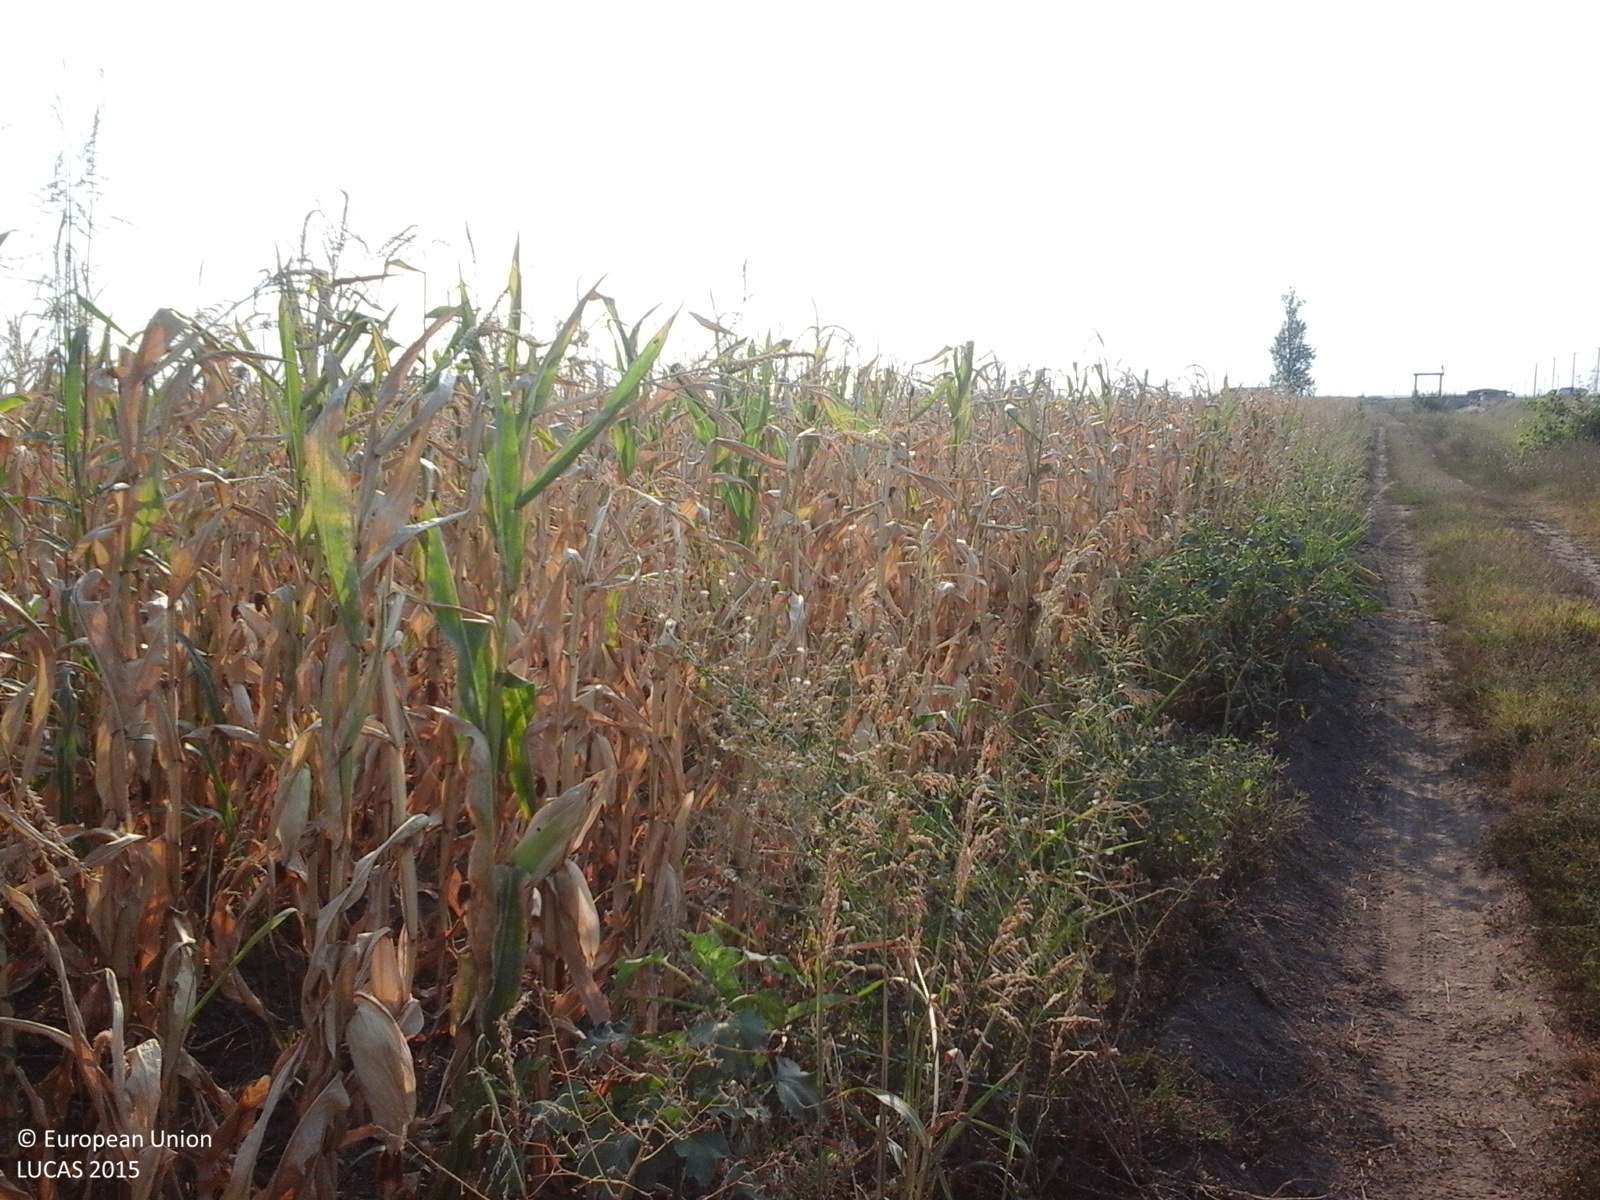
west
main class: Cropland
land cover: Maize
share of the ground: > 75 %
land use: Agriculture (excluding fallow land and kitchen gardens)
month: August
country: RO
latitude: 43.9992
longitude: 23.1757
